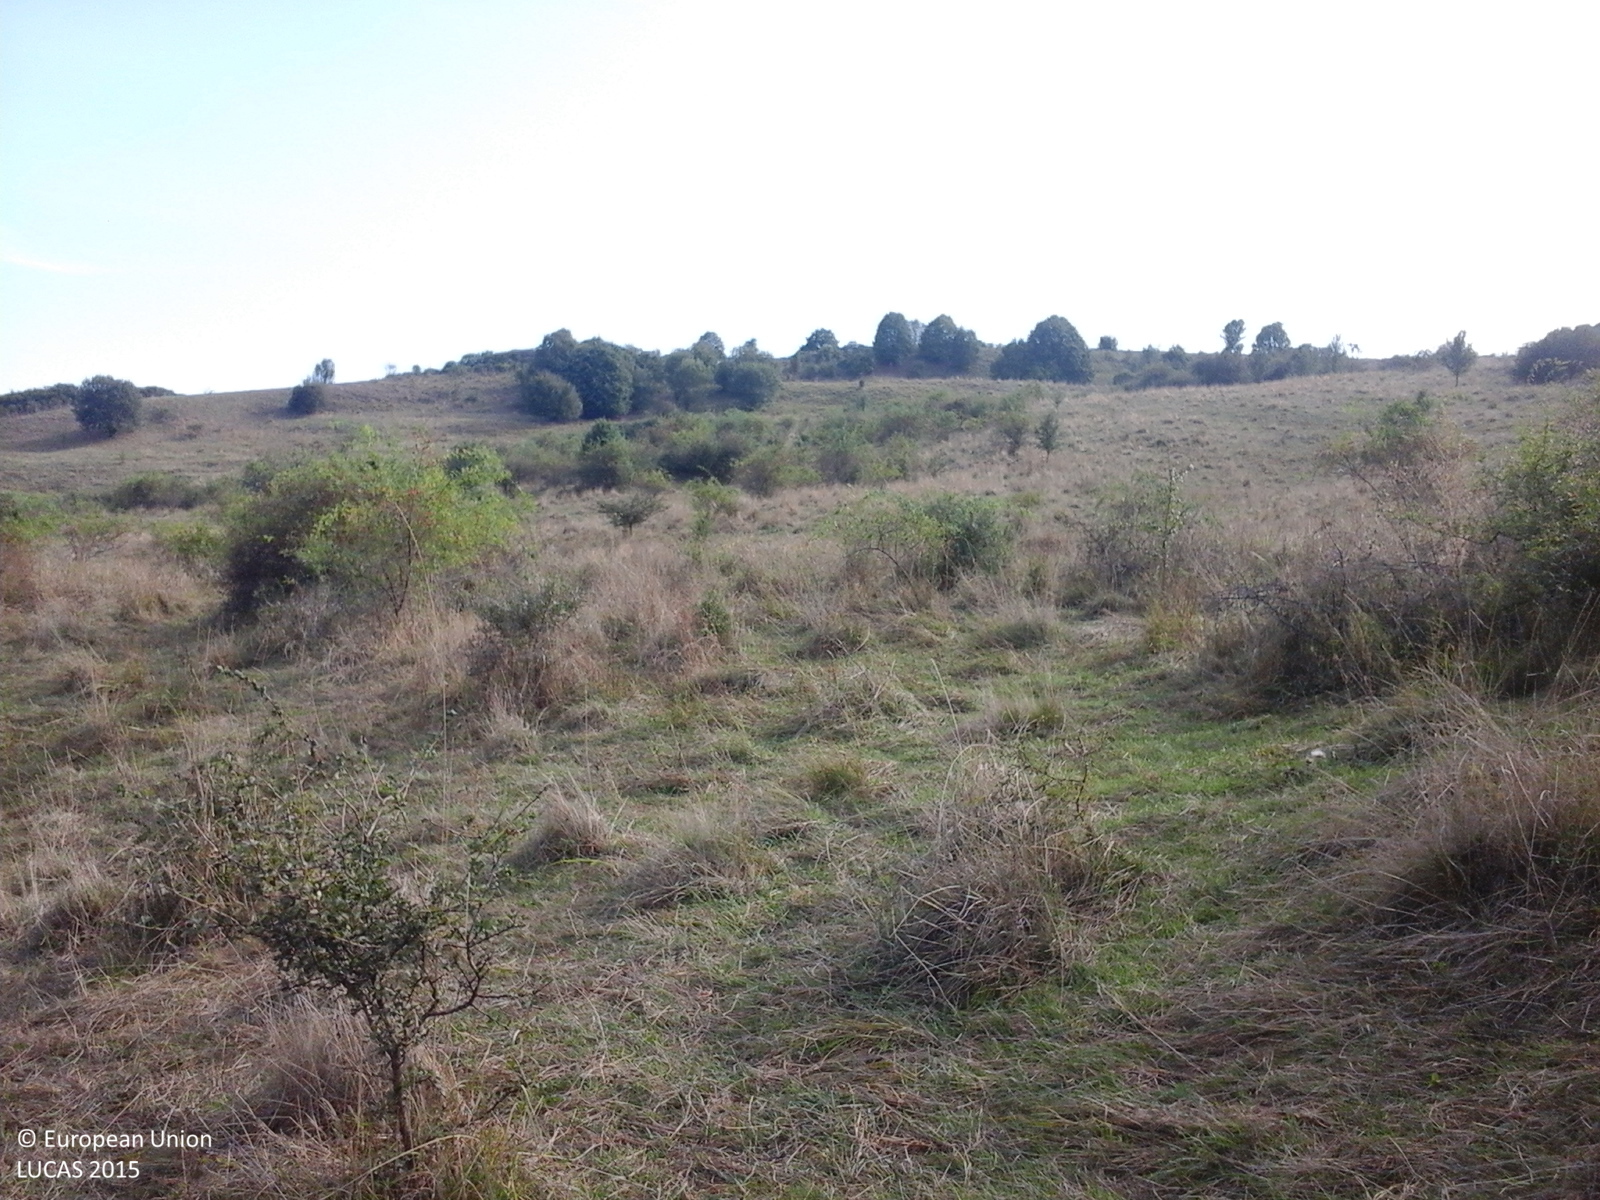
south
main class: Grassland
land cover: Grassland with sparse tree/shrub cover
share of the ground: > 75 %
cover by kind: herbaceous plants 85 %, shrubs 10 %, broadleaved forest trees 5 %
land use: Agriculture (excluding fallow land and kitchen gardens)
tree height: < 5 m
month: September
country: RO
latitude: 47.1125
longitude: 23.6618
